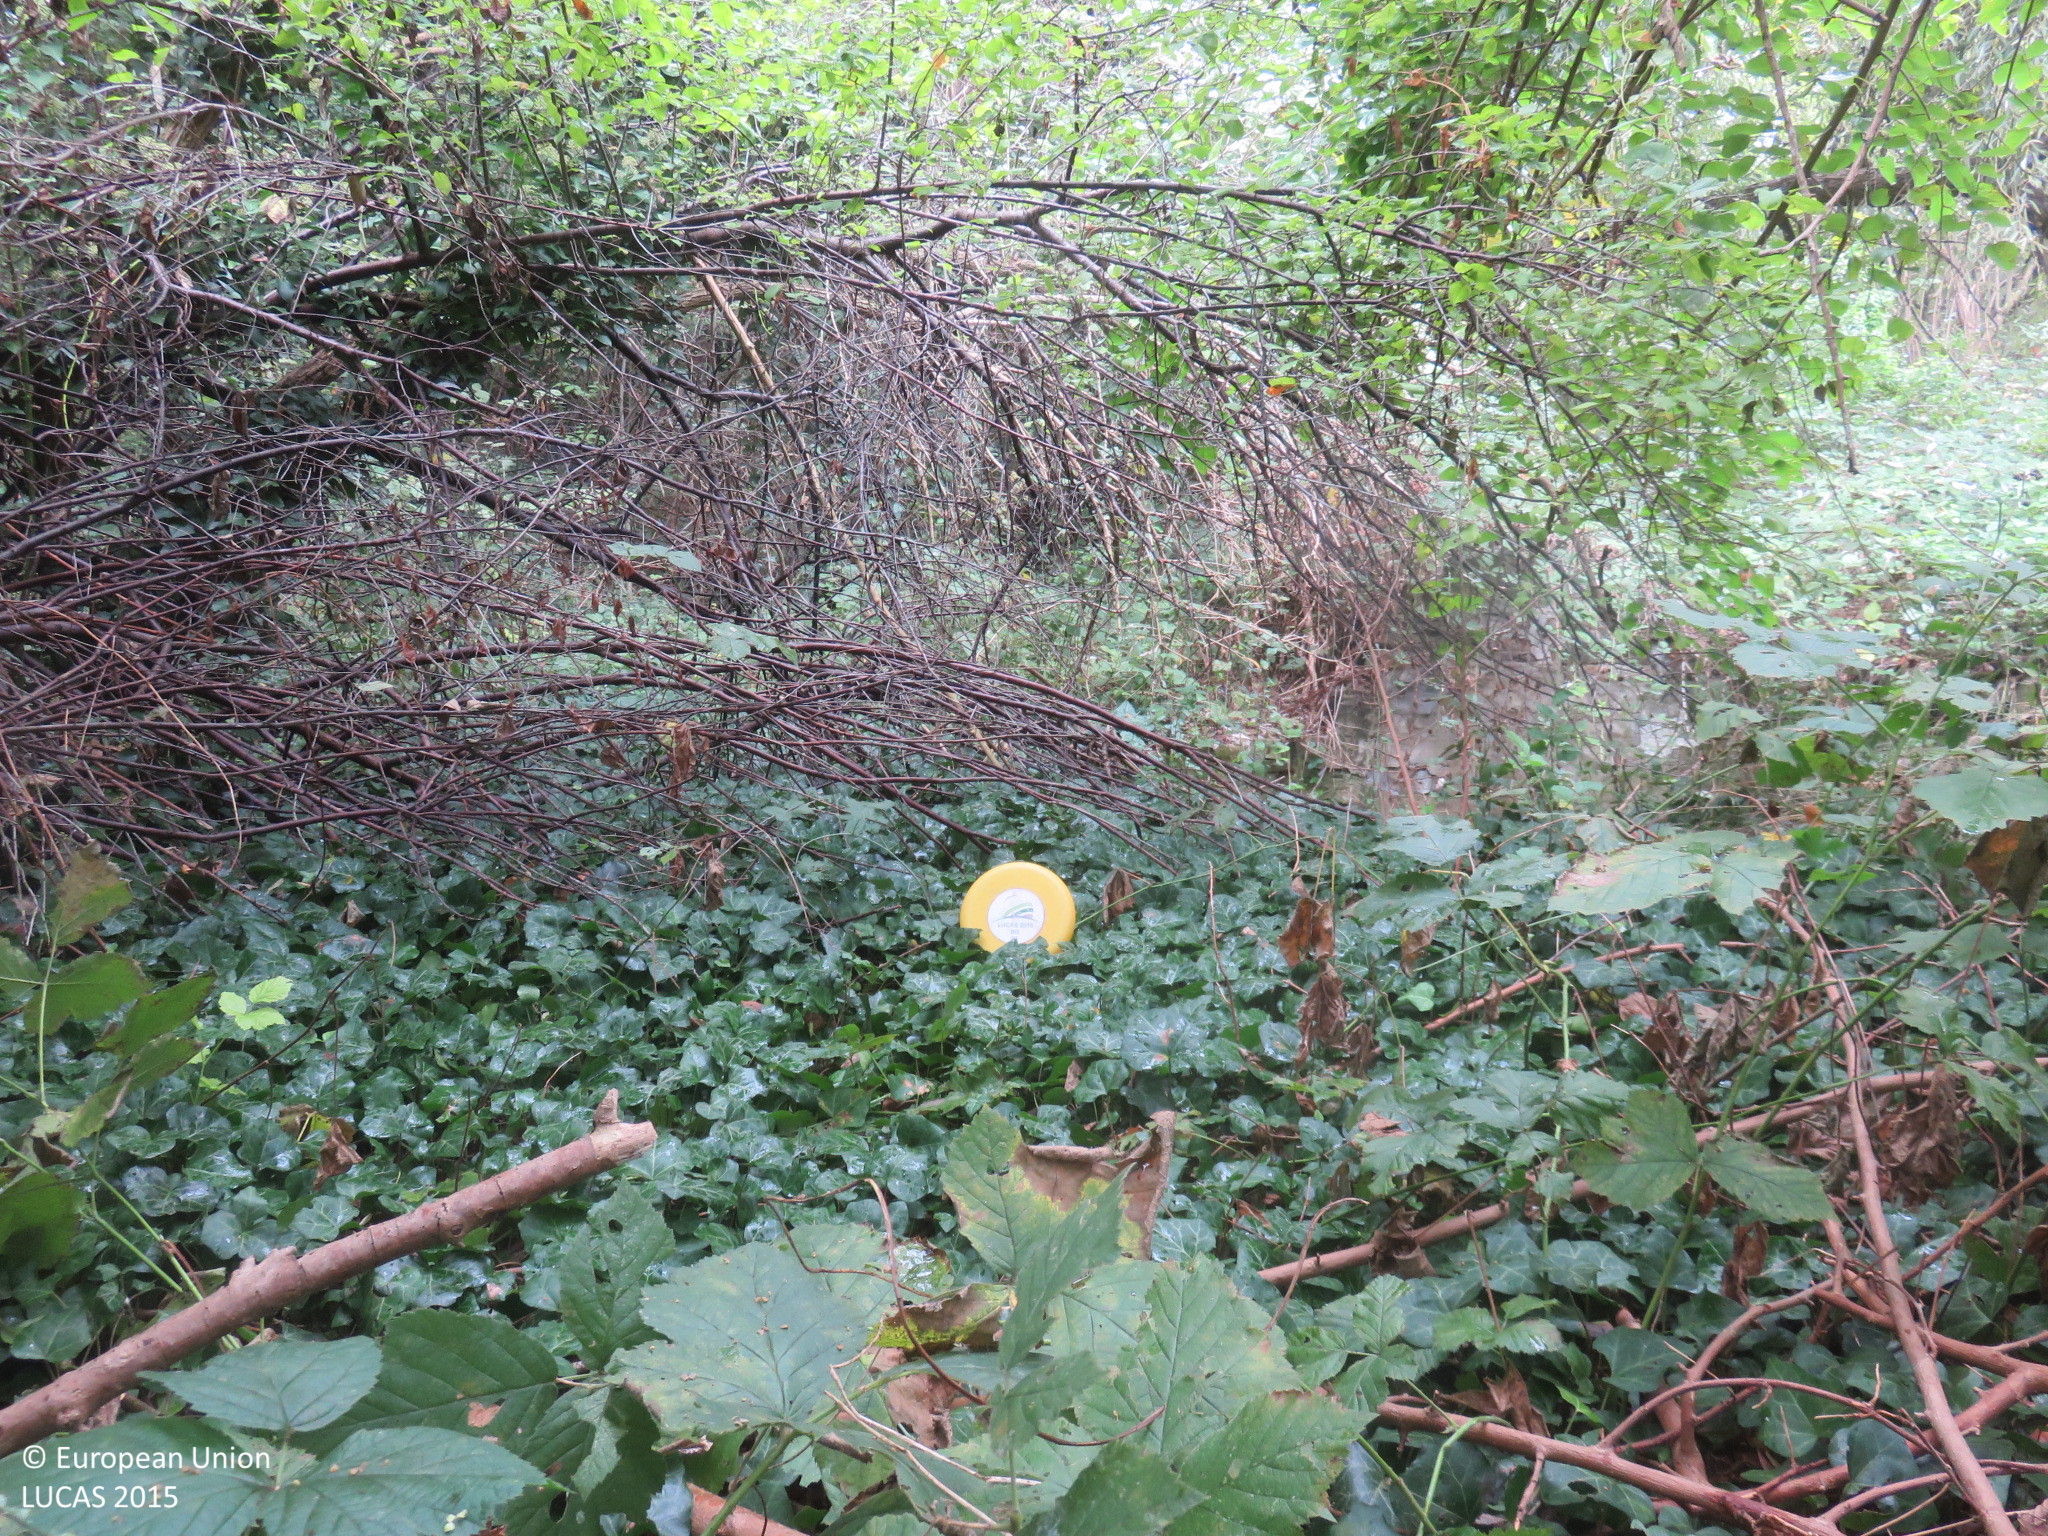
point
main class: Woodland
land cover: Broadleaved woodland
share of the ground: > 75 %
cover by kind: broadleaved forest trees 80 %, shrubs 10 %, herbaceous plants 10 %
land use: Residential
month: September
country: BG
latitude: 43.0999
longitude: 24.7947
